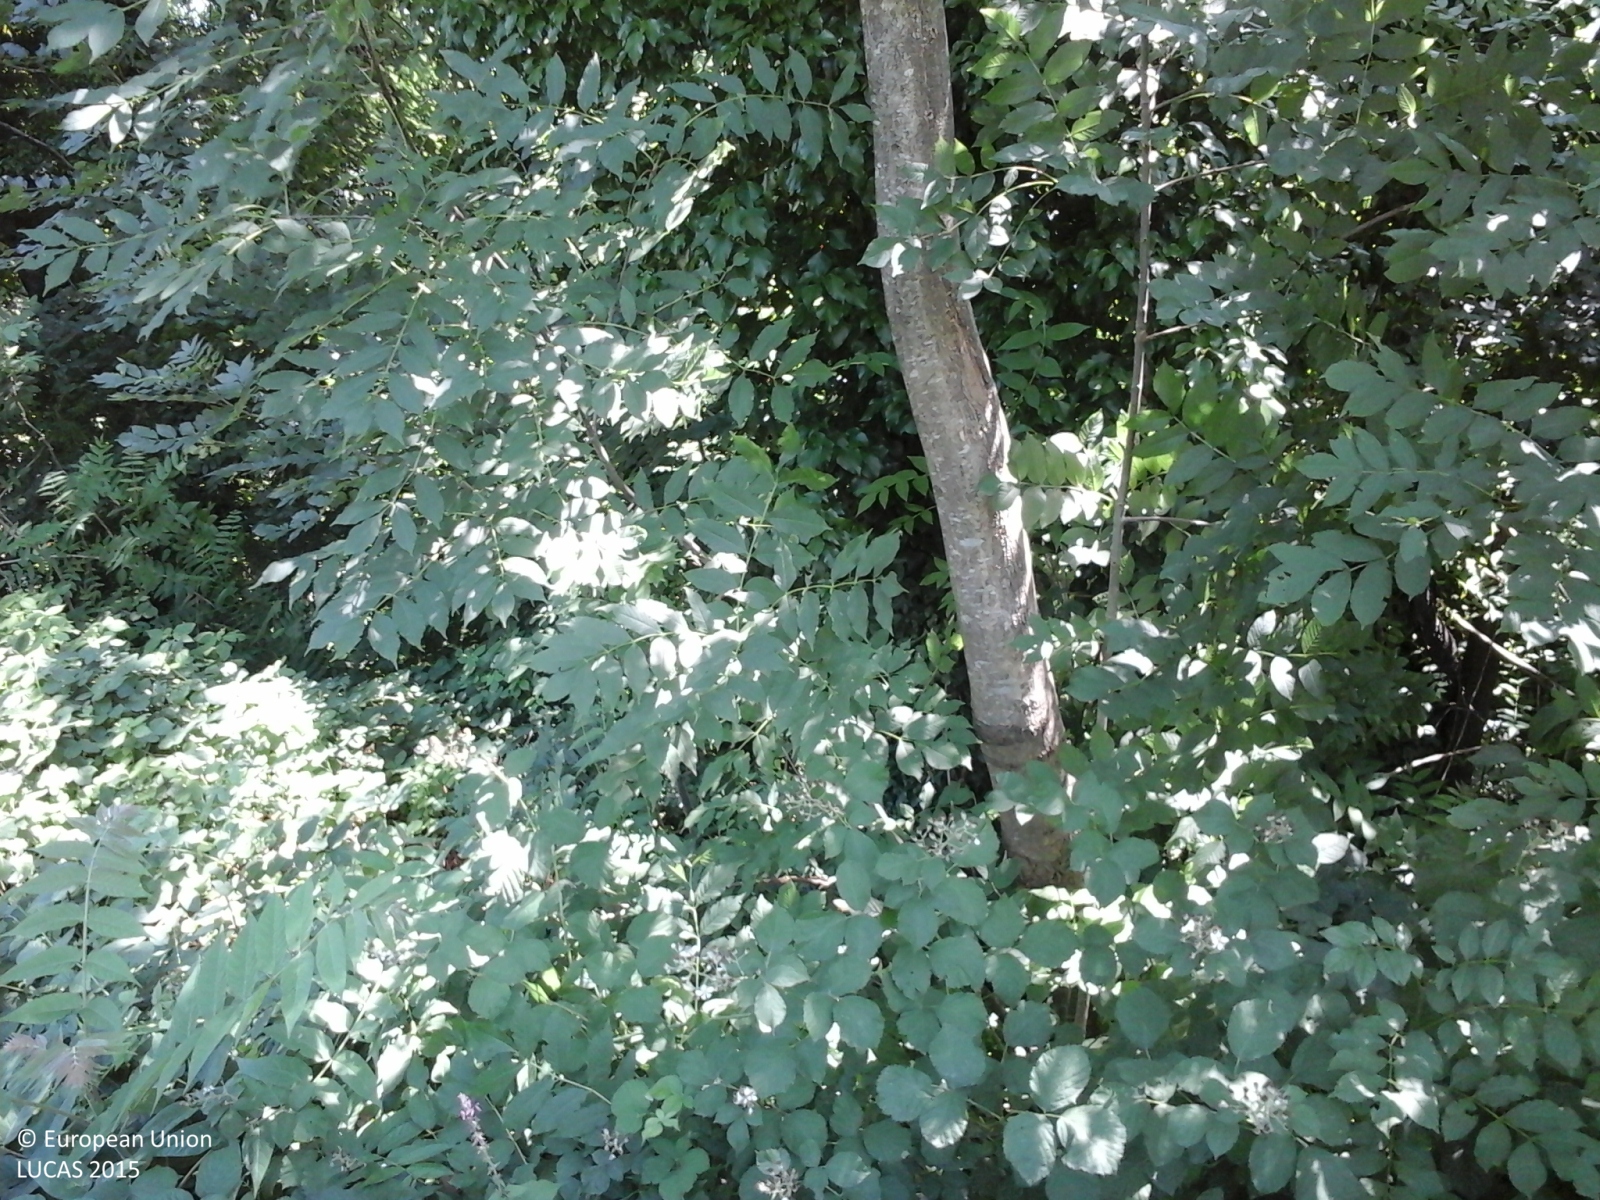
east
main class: Woodland
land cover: Broadleaved woodland
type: thermophilous deciduous forest
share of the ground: > 75 %
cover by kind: broadleaved forest trees 80 %, shrubs 15 %, herbaceous plants 5 %
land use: Semi-natural and natural areas not in use
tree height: > 5 m
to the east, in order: Broadleaved woodland; Inland fresh running water; Broadleaved woodland; Paved roads, cycling and walking lanes; Broadleaved woodland
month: June
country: IT
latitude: 44.3794
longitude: 7.7080
